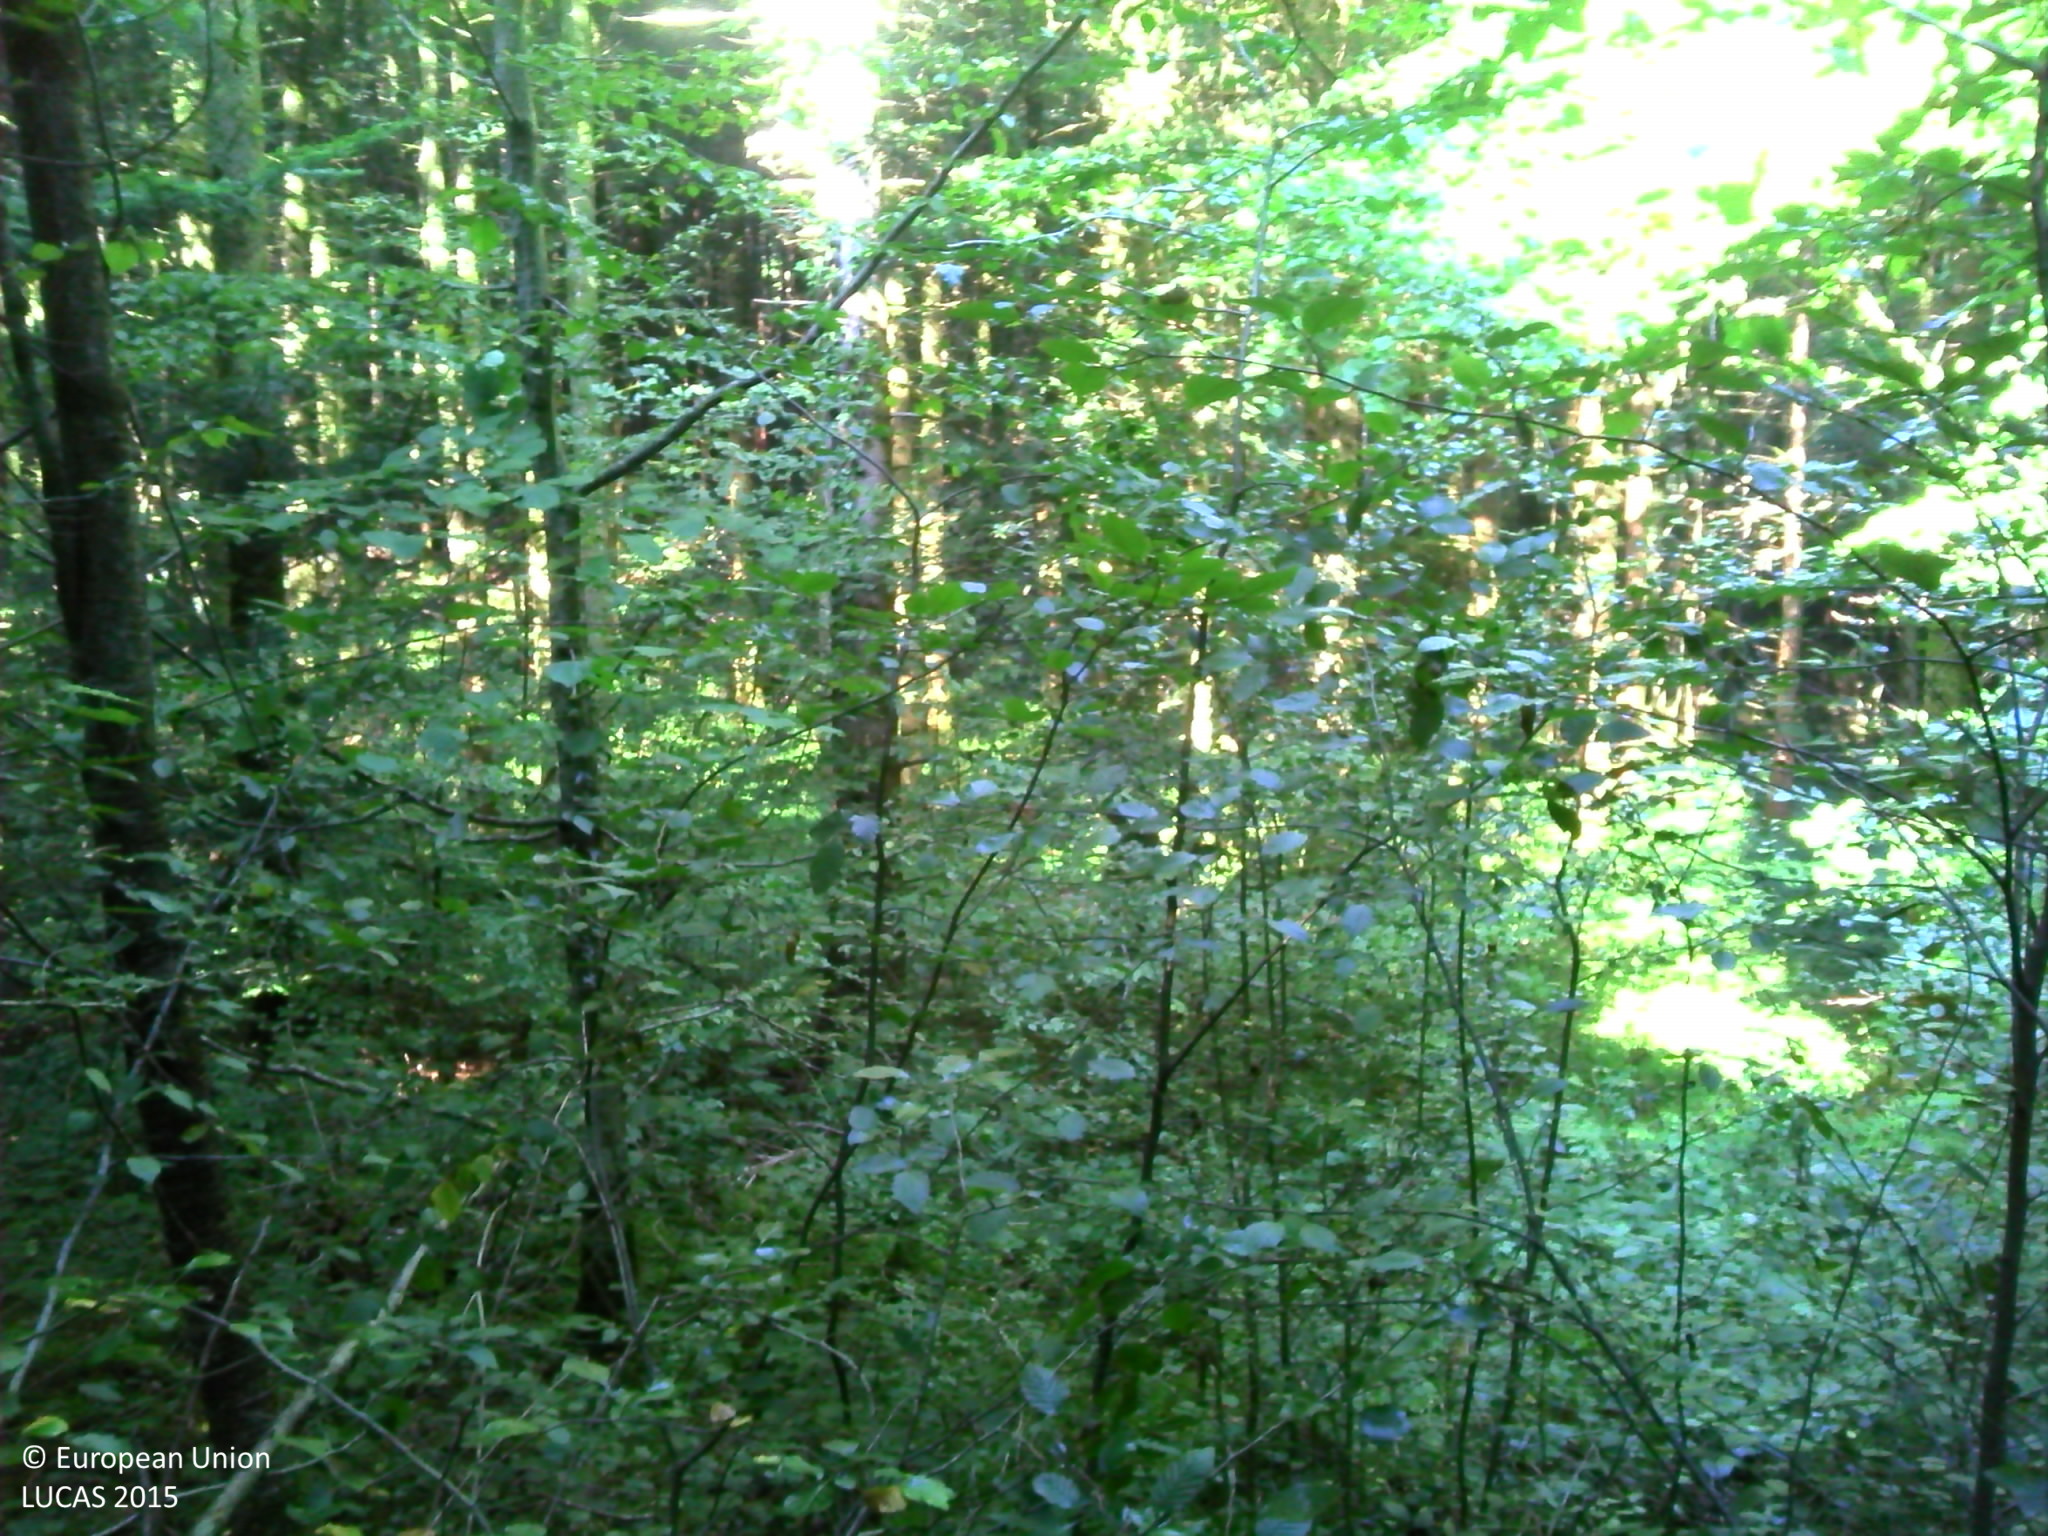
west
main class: Woodland
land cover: Spruce dominated mixed woodland
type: mesophytic deciduous forest
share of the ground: > 75 %
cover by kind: coniferous forest trees 40 %, broadleaved forest trees 40 %, shrubs 5 %, herbaceous plants 5 %, lichens and mosses 5 %, consolidated bare surface 5 %
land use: Forestry
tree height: > 5 m
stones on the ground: < 10 %
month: September
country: FR
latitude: 47.2782
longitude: 6.2871
